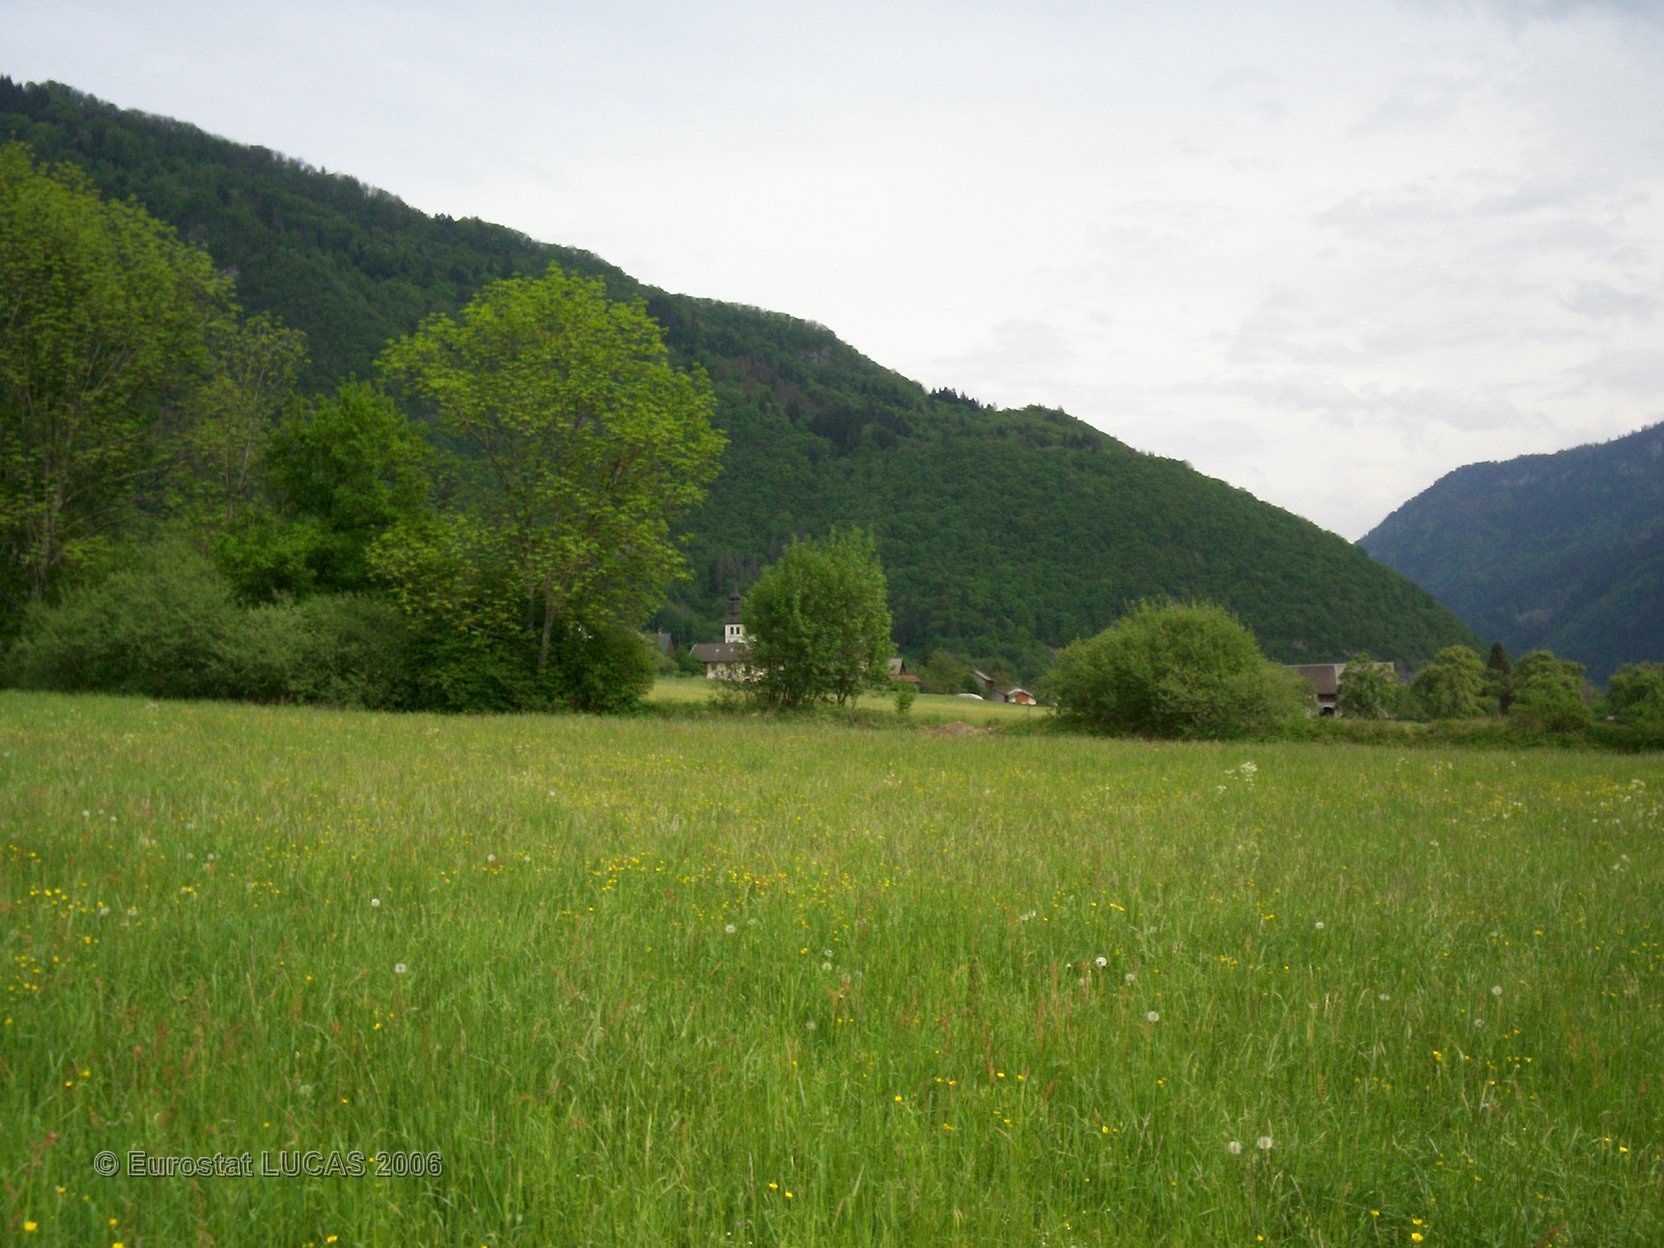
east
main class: Grassland
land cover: Grassland without tree/shrub cover
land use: Agriculture (excluding fallow land and kitchen gardens)
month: May
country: FR
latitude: 46.1470
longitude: 6.4173
